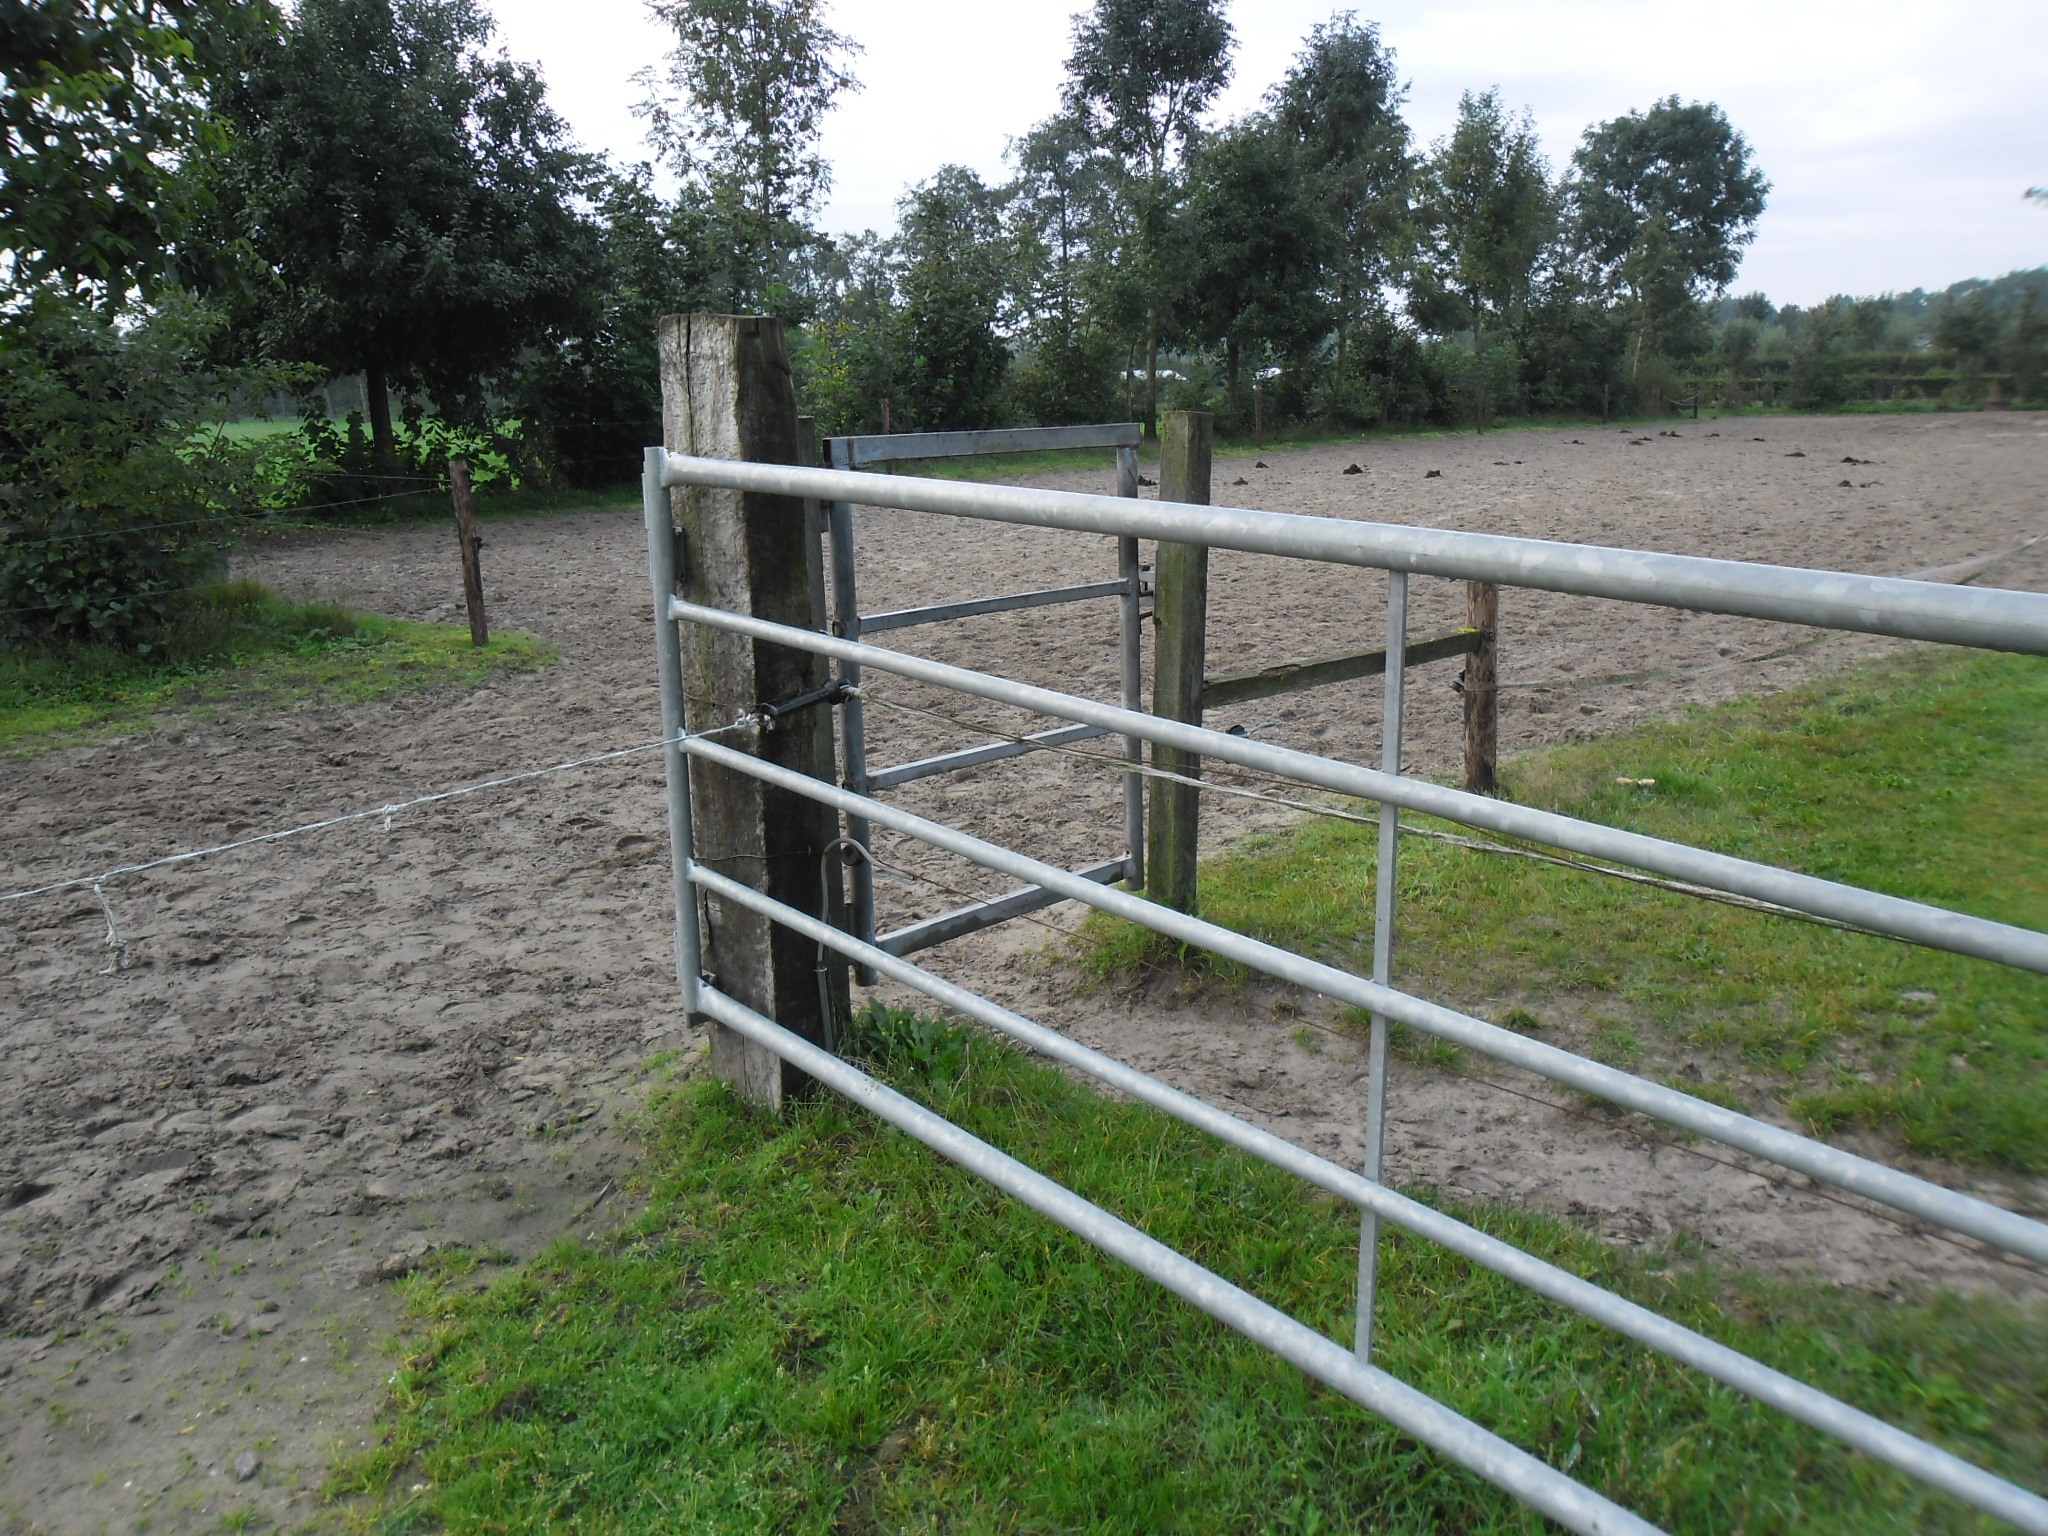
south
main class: Grassland
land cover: Grassland without tree/shrub cover
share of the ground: > 75 %
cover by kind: herbaceous plants 100 %
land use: Agriculture (excluding fallow land and kitchen gardens)
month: September
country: NL
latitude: 52.1128
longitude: 5.5153
